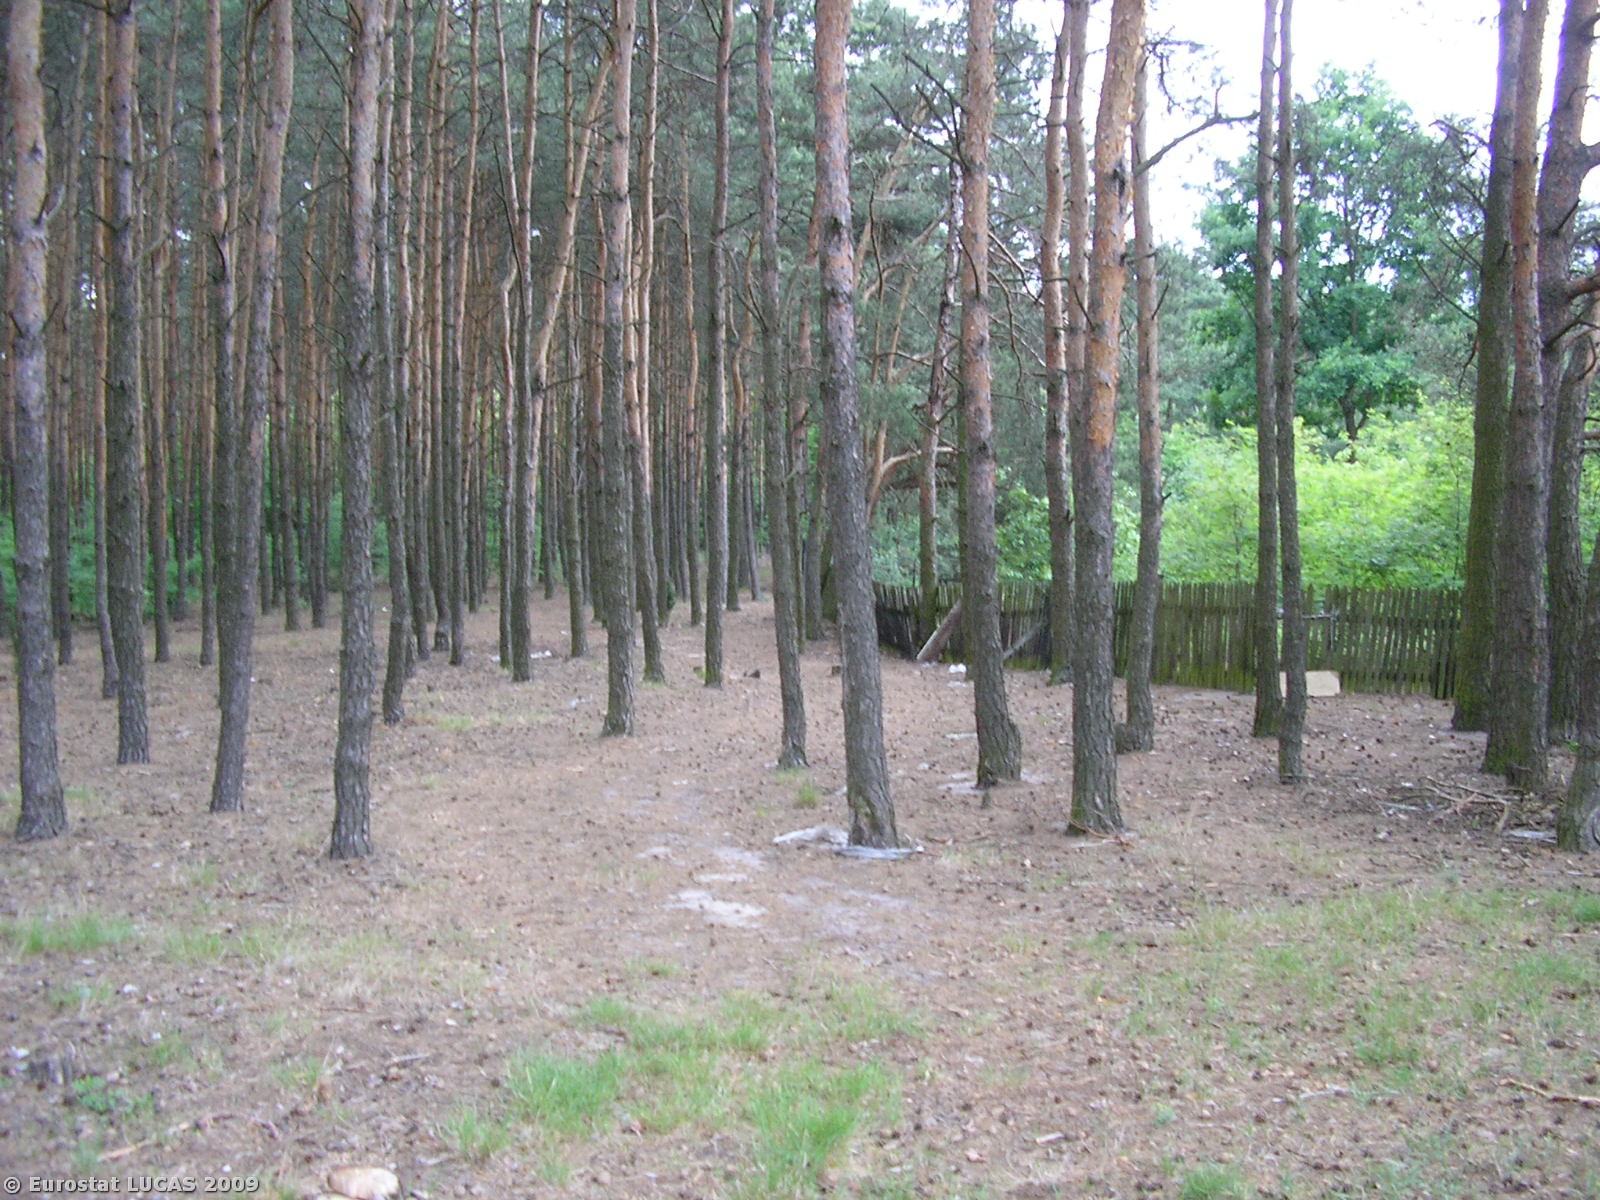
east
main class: Woodland
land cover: Coniferous woodland
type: hemiboreal forest and nemoral coniferous forest and mixed broadleaved-coniferous forest
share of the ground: 50 - 75 %
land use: Forestry
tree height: > 5 m
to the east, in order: Coniferous woodland; Tracks; Coniferous woodland; Broadleaved woodland; Coniferous woodland; Tracks; Coniferous woodland
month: June
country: PL
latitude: 51.4948
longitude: 18.9679
